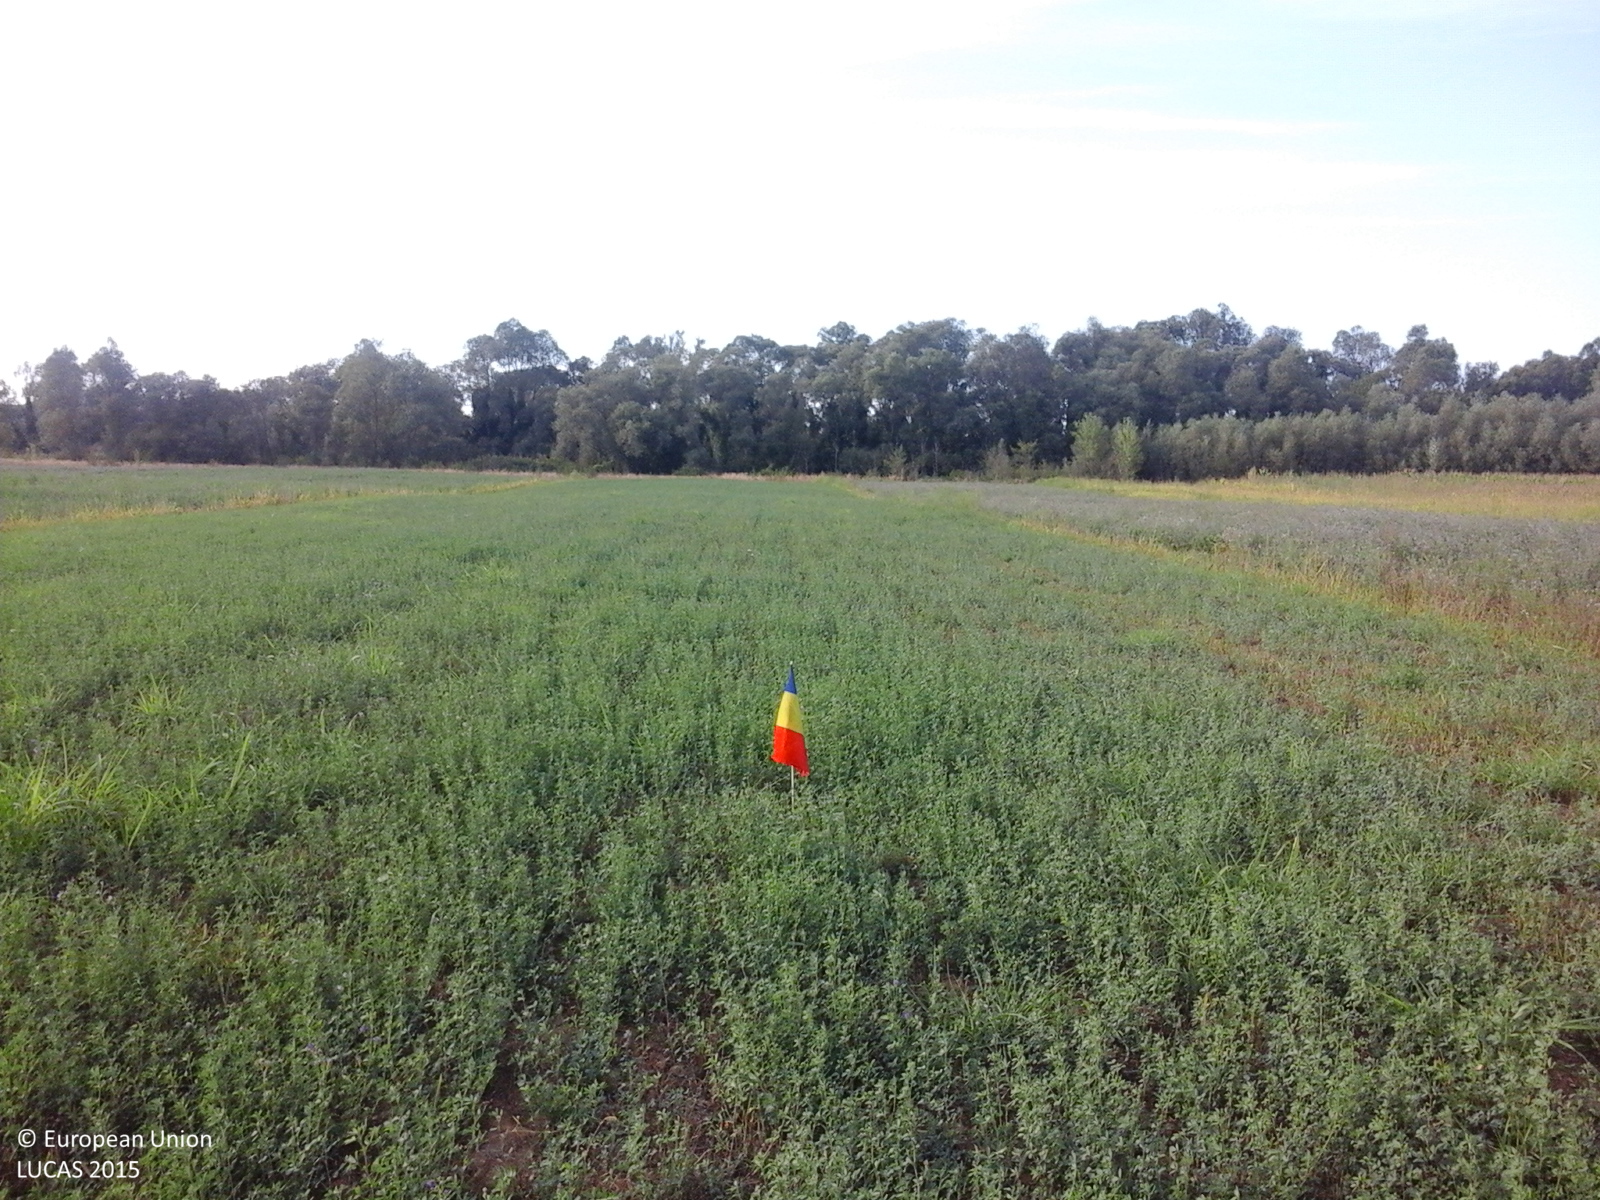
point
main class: Cropland
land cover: Lucerne
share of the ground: > 75 %
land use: Agriculture (excluding fallow land and kitchen gardens)
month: August
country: RO
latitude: 45.1311
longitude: 21.6404
